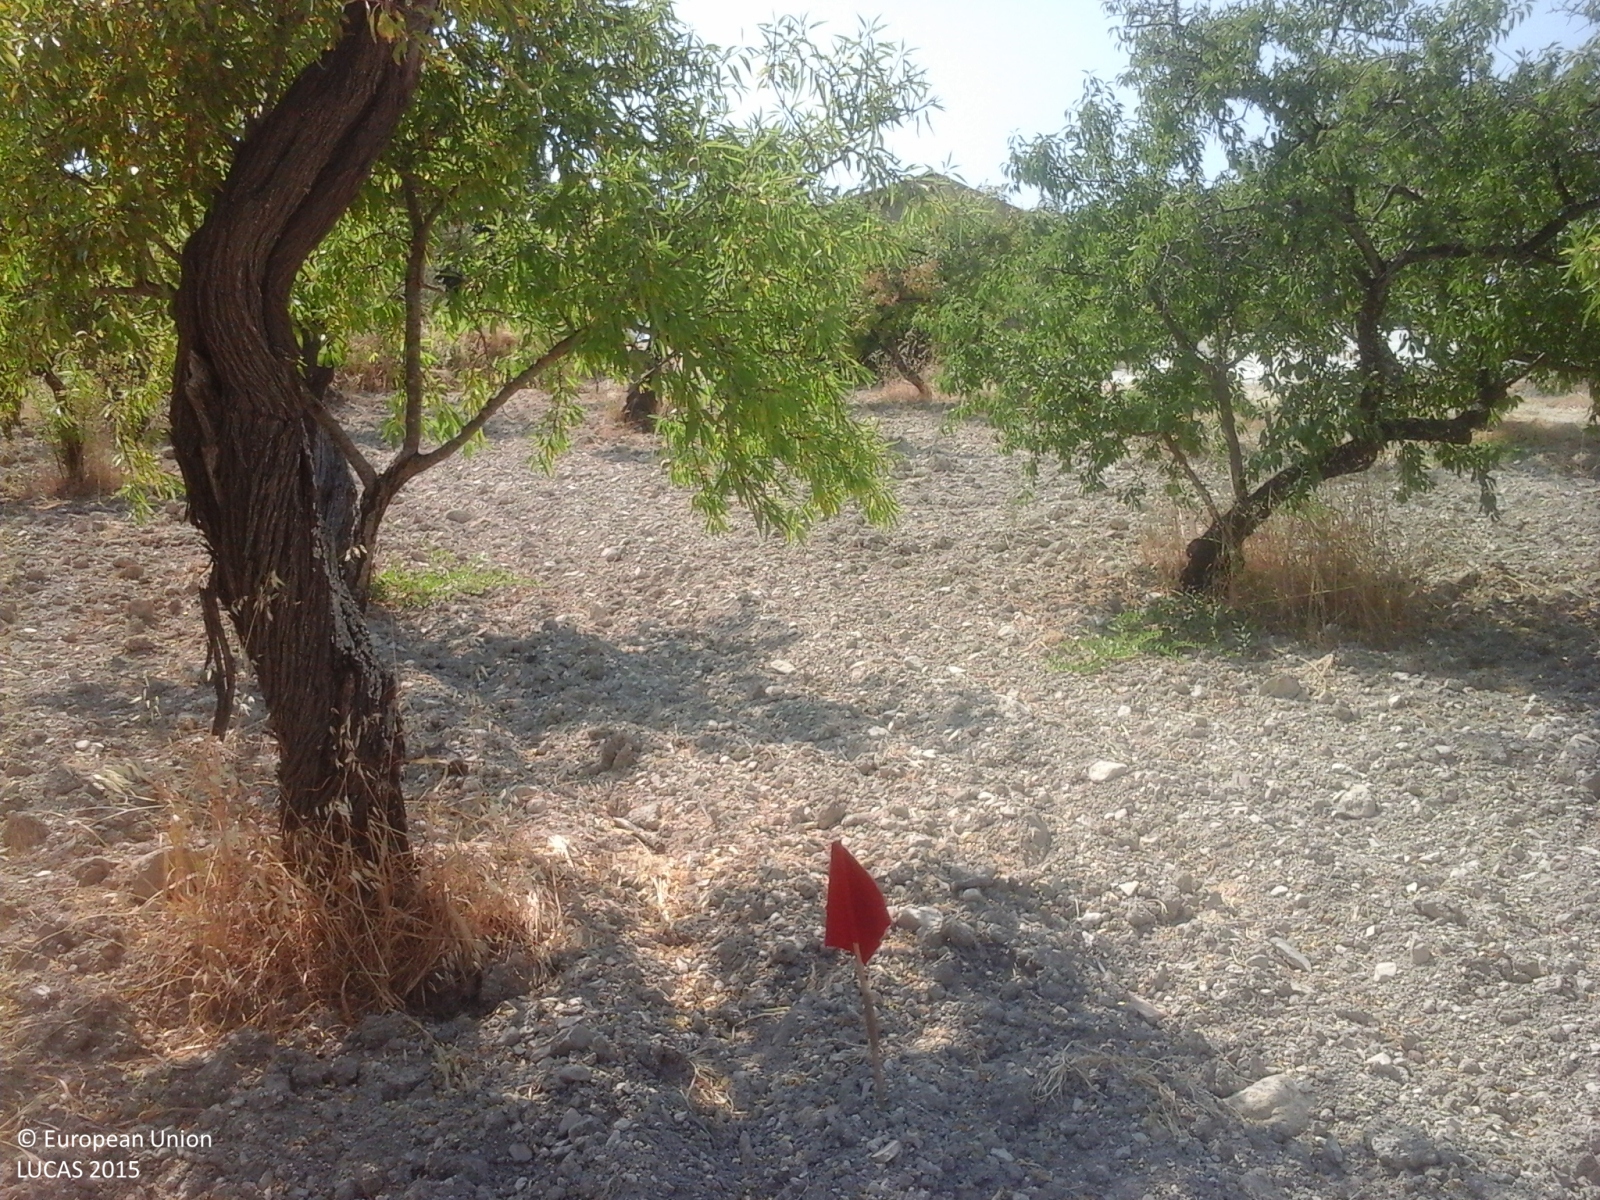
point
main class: Cropland
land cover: Nuts trees
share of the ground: 25 - 50 %
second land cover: Other bare soil
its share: > 75 %
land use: Agriculture (excluding fallow land and kitchen gardens)
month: July
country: IT
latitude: 37.4250
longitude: 13.5998
